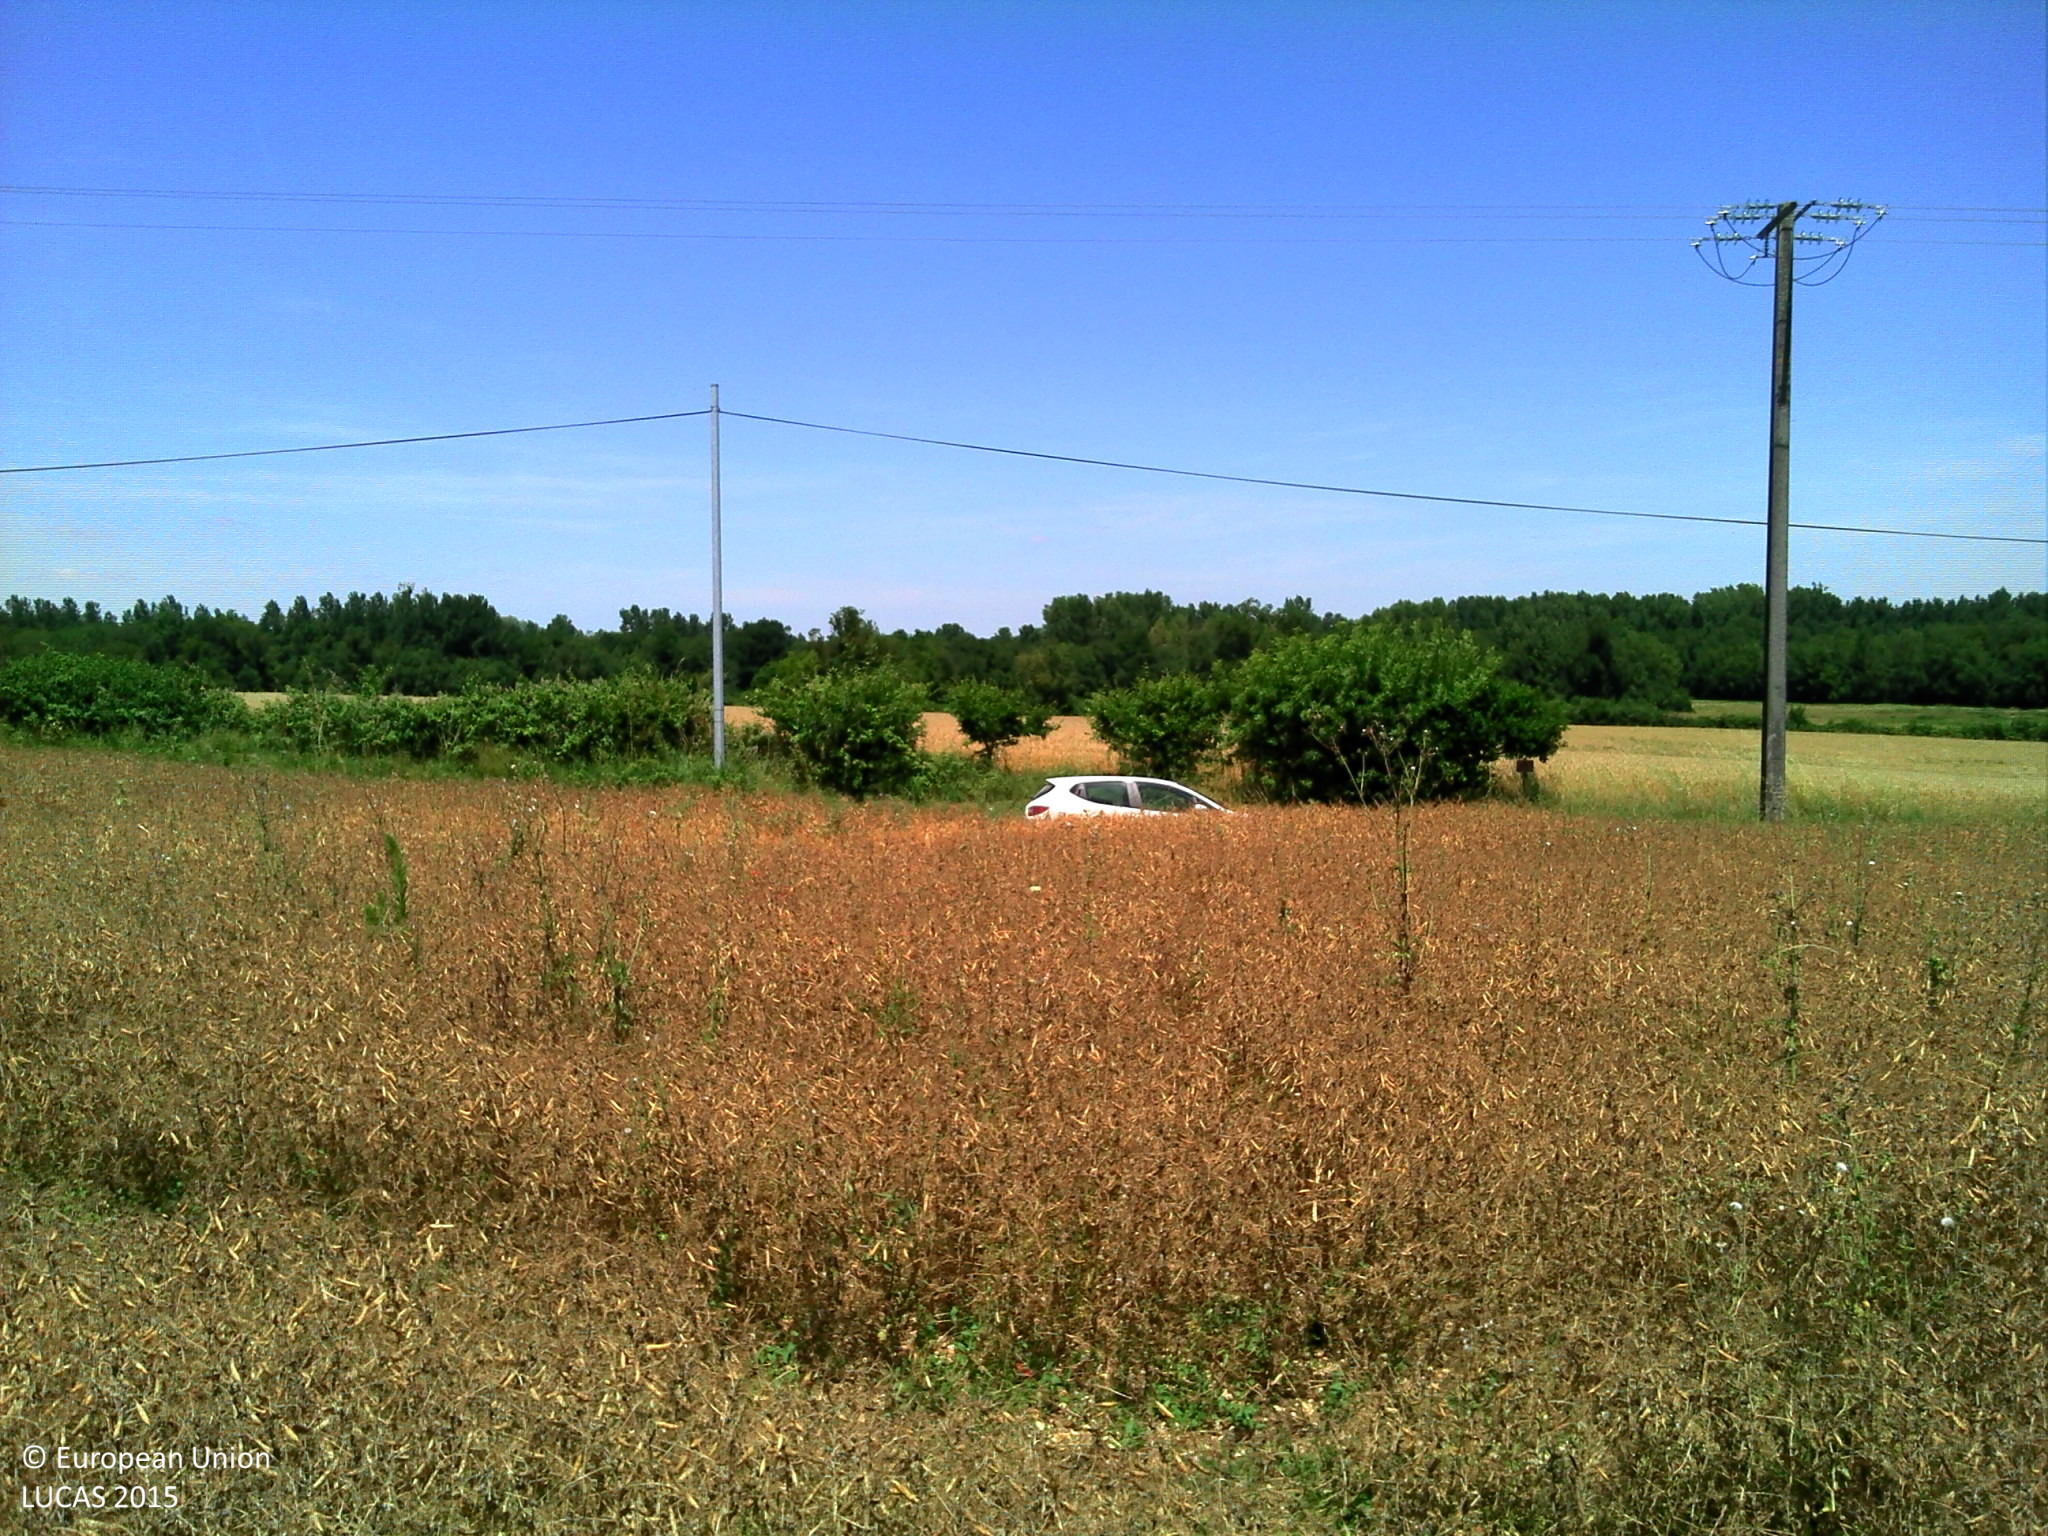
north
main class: Cropland
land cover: Dry pulses
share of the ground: > 75 %
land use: Agriculture (excluding fallow land and kitchen gardens)
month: June
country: FR
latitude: 45.8517
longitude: -0.6753
